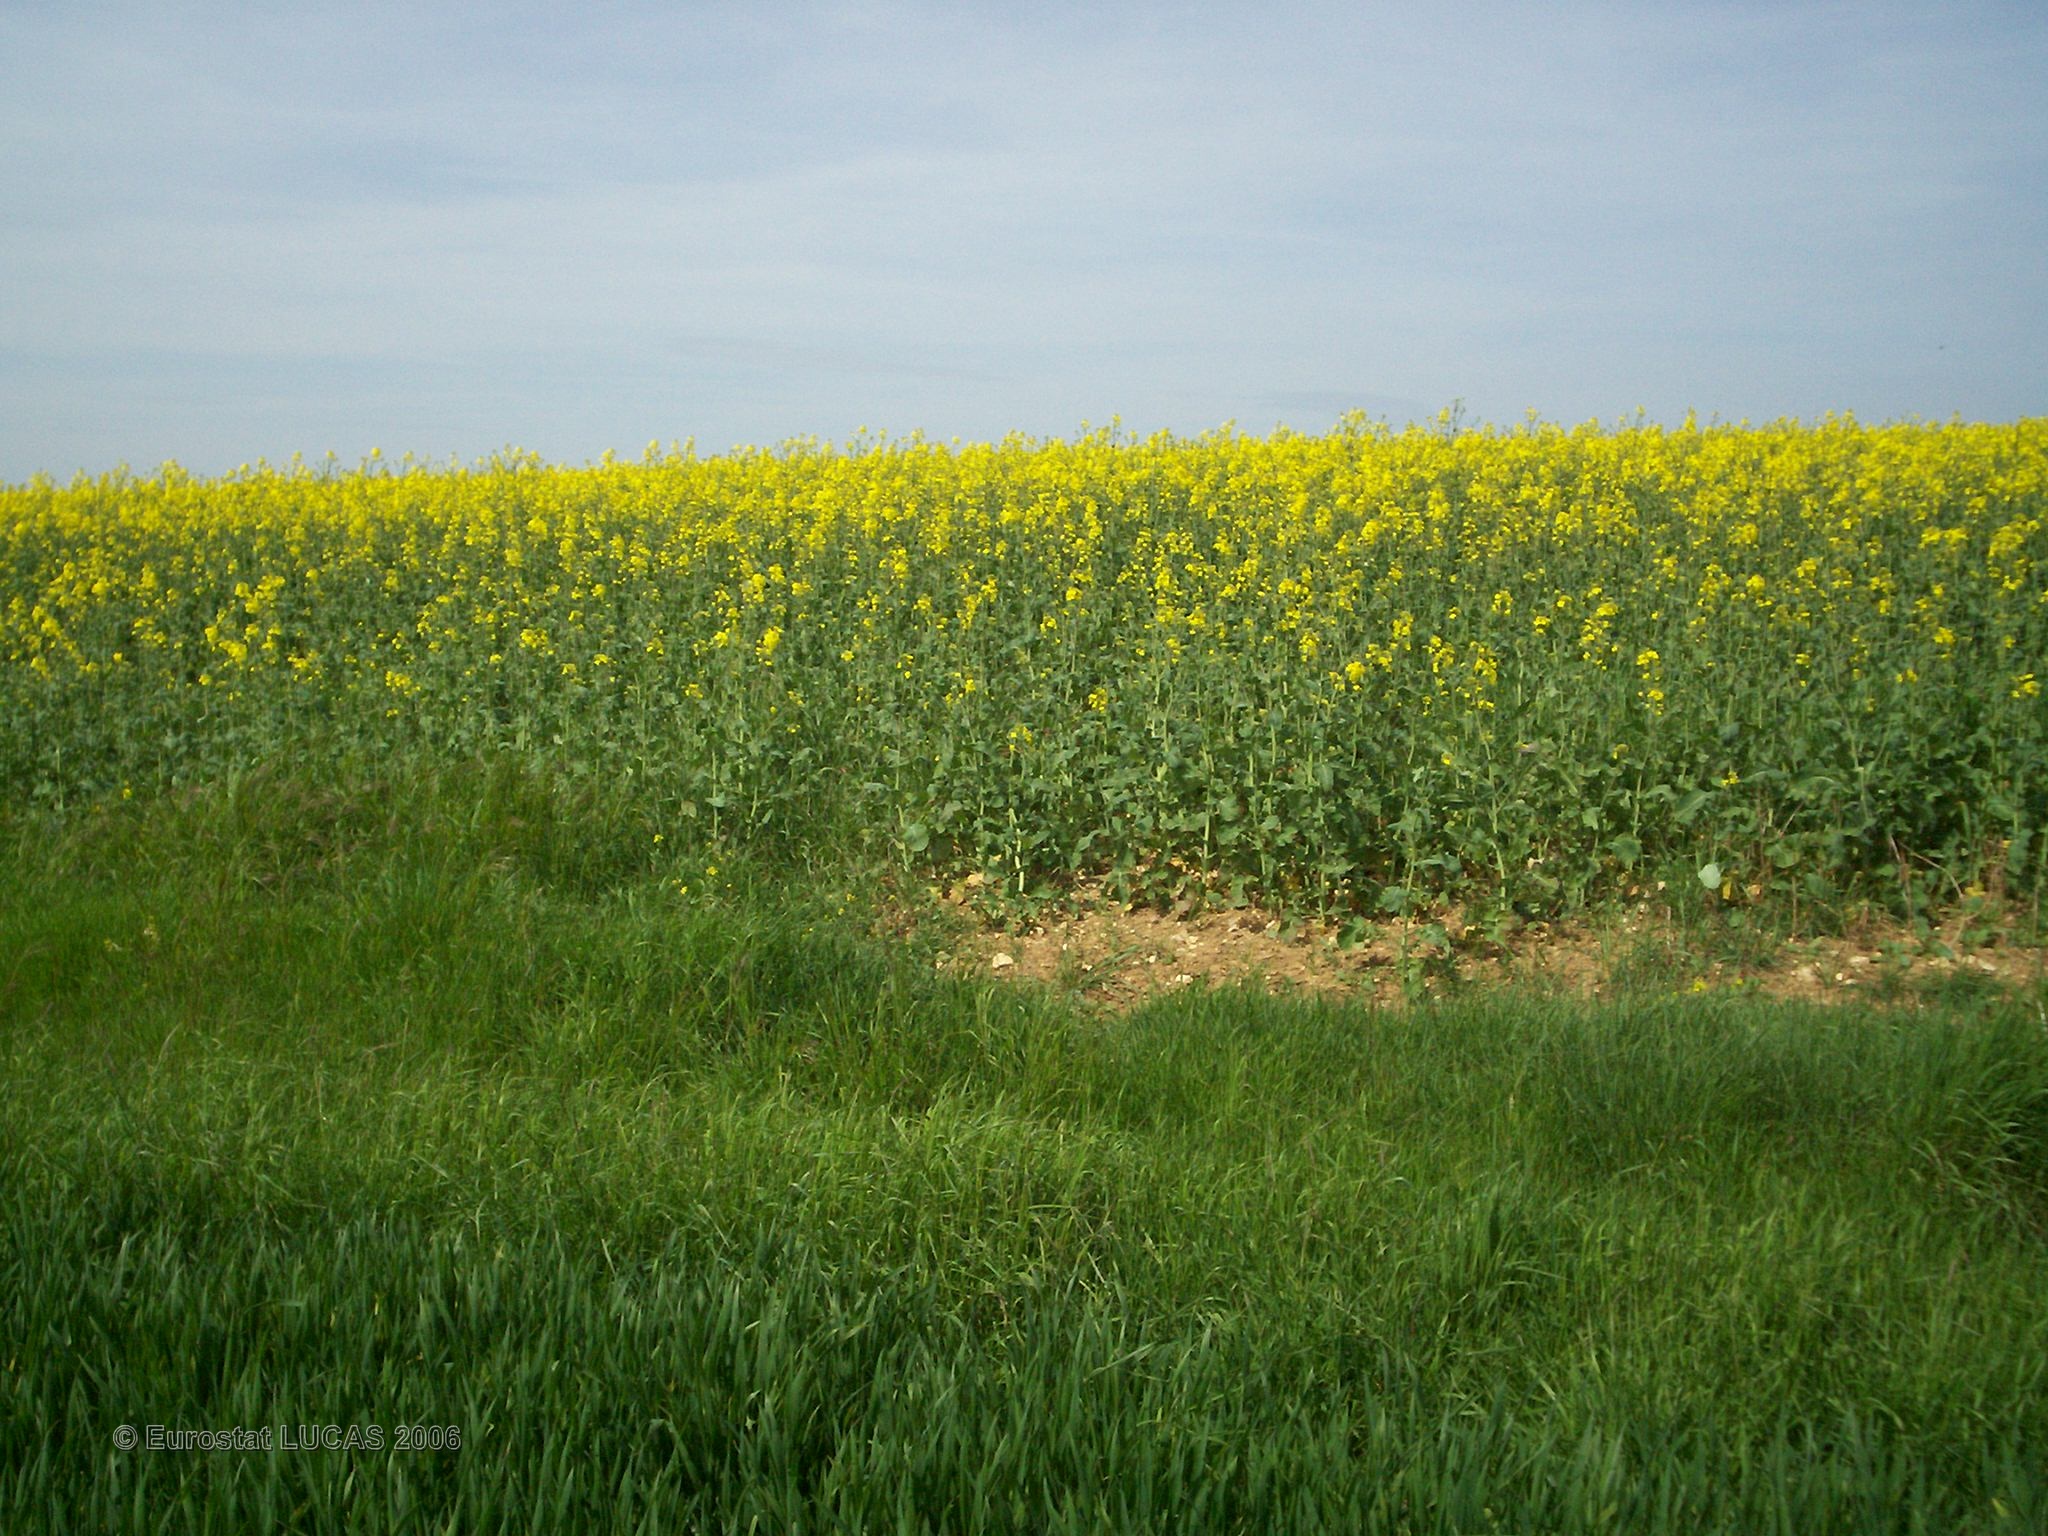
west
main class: Cropland
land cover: Common wheat
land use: Agriculture (excluding fallow land and kitchen gardens)
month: May
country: FR
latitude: 47.8884
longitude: 3.8310
